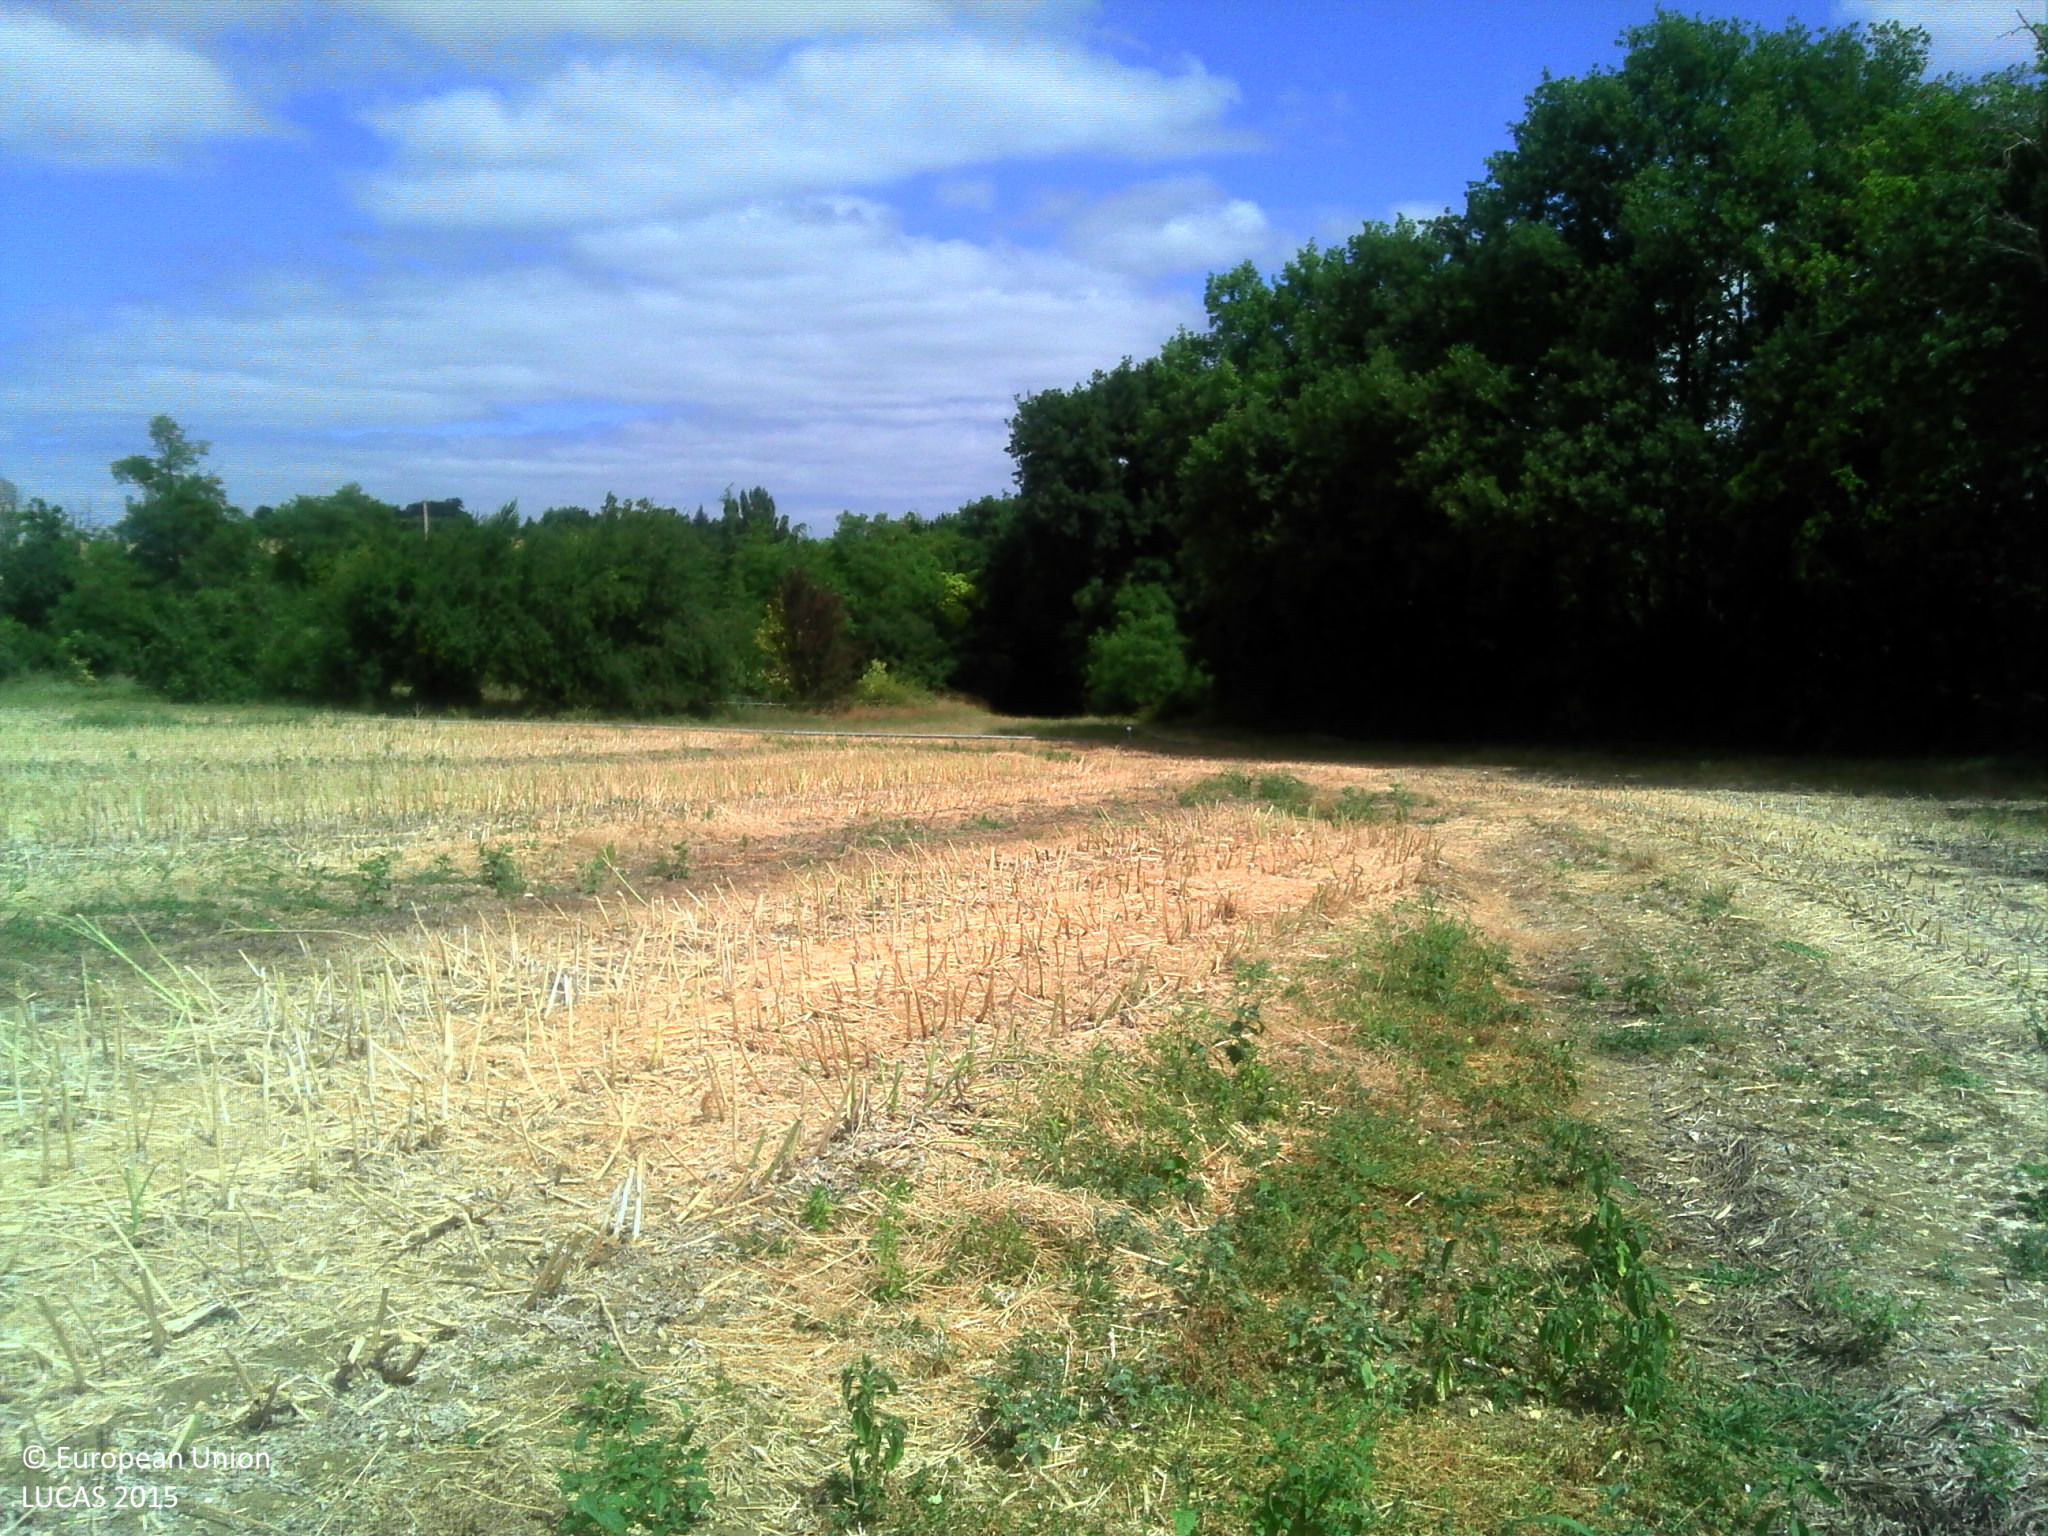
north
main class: Cropland
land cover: Rape and turnip rape
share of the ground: > 75 %
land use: Agriculture (excluding fallow land and kitchen gardens)
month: July
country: FR
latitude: 43.9157
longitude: 0.7192
